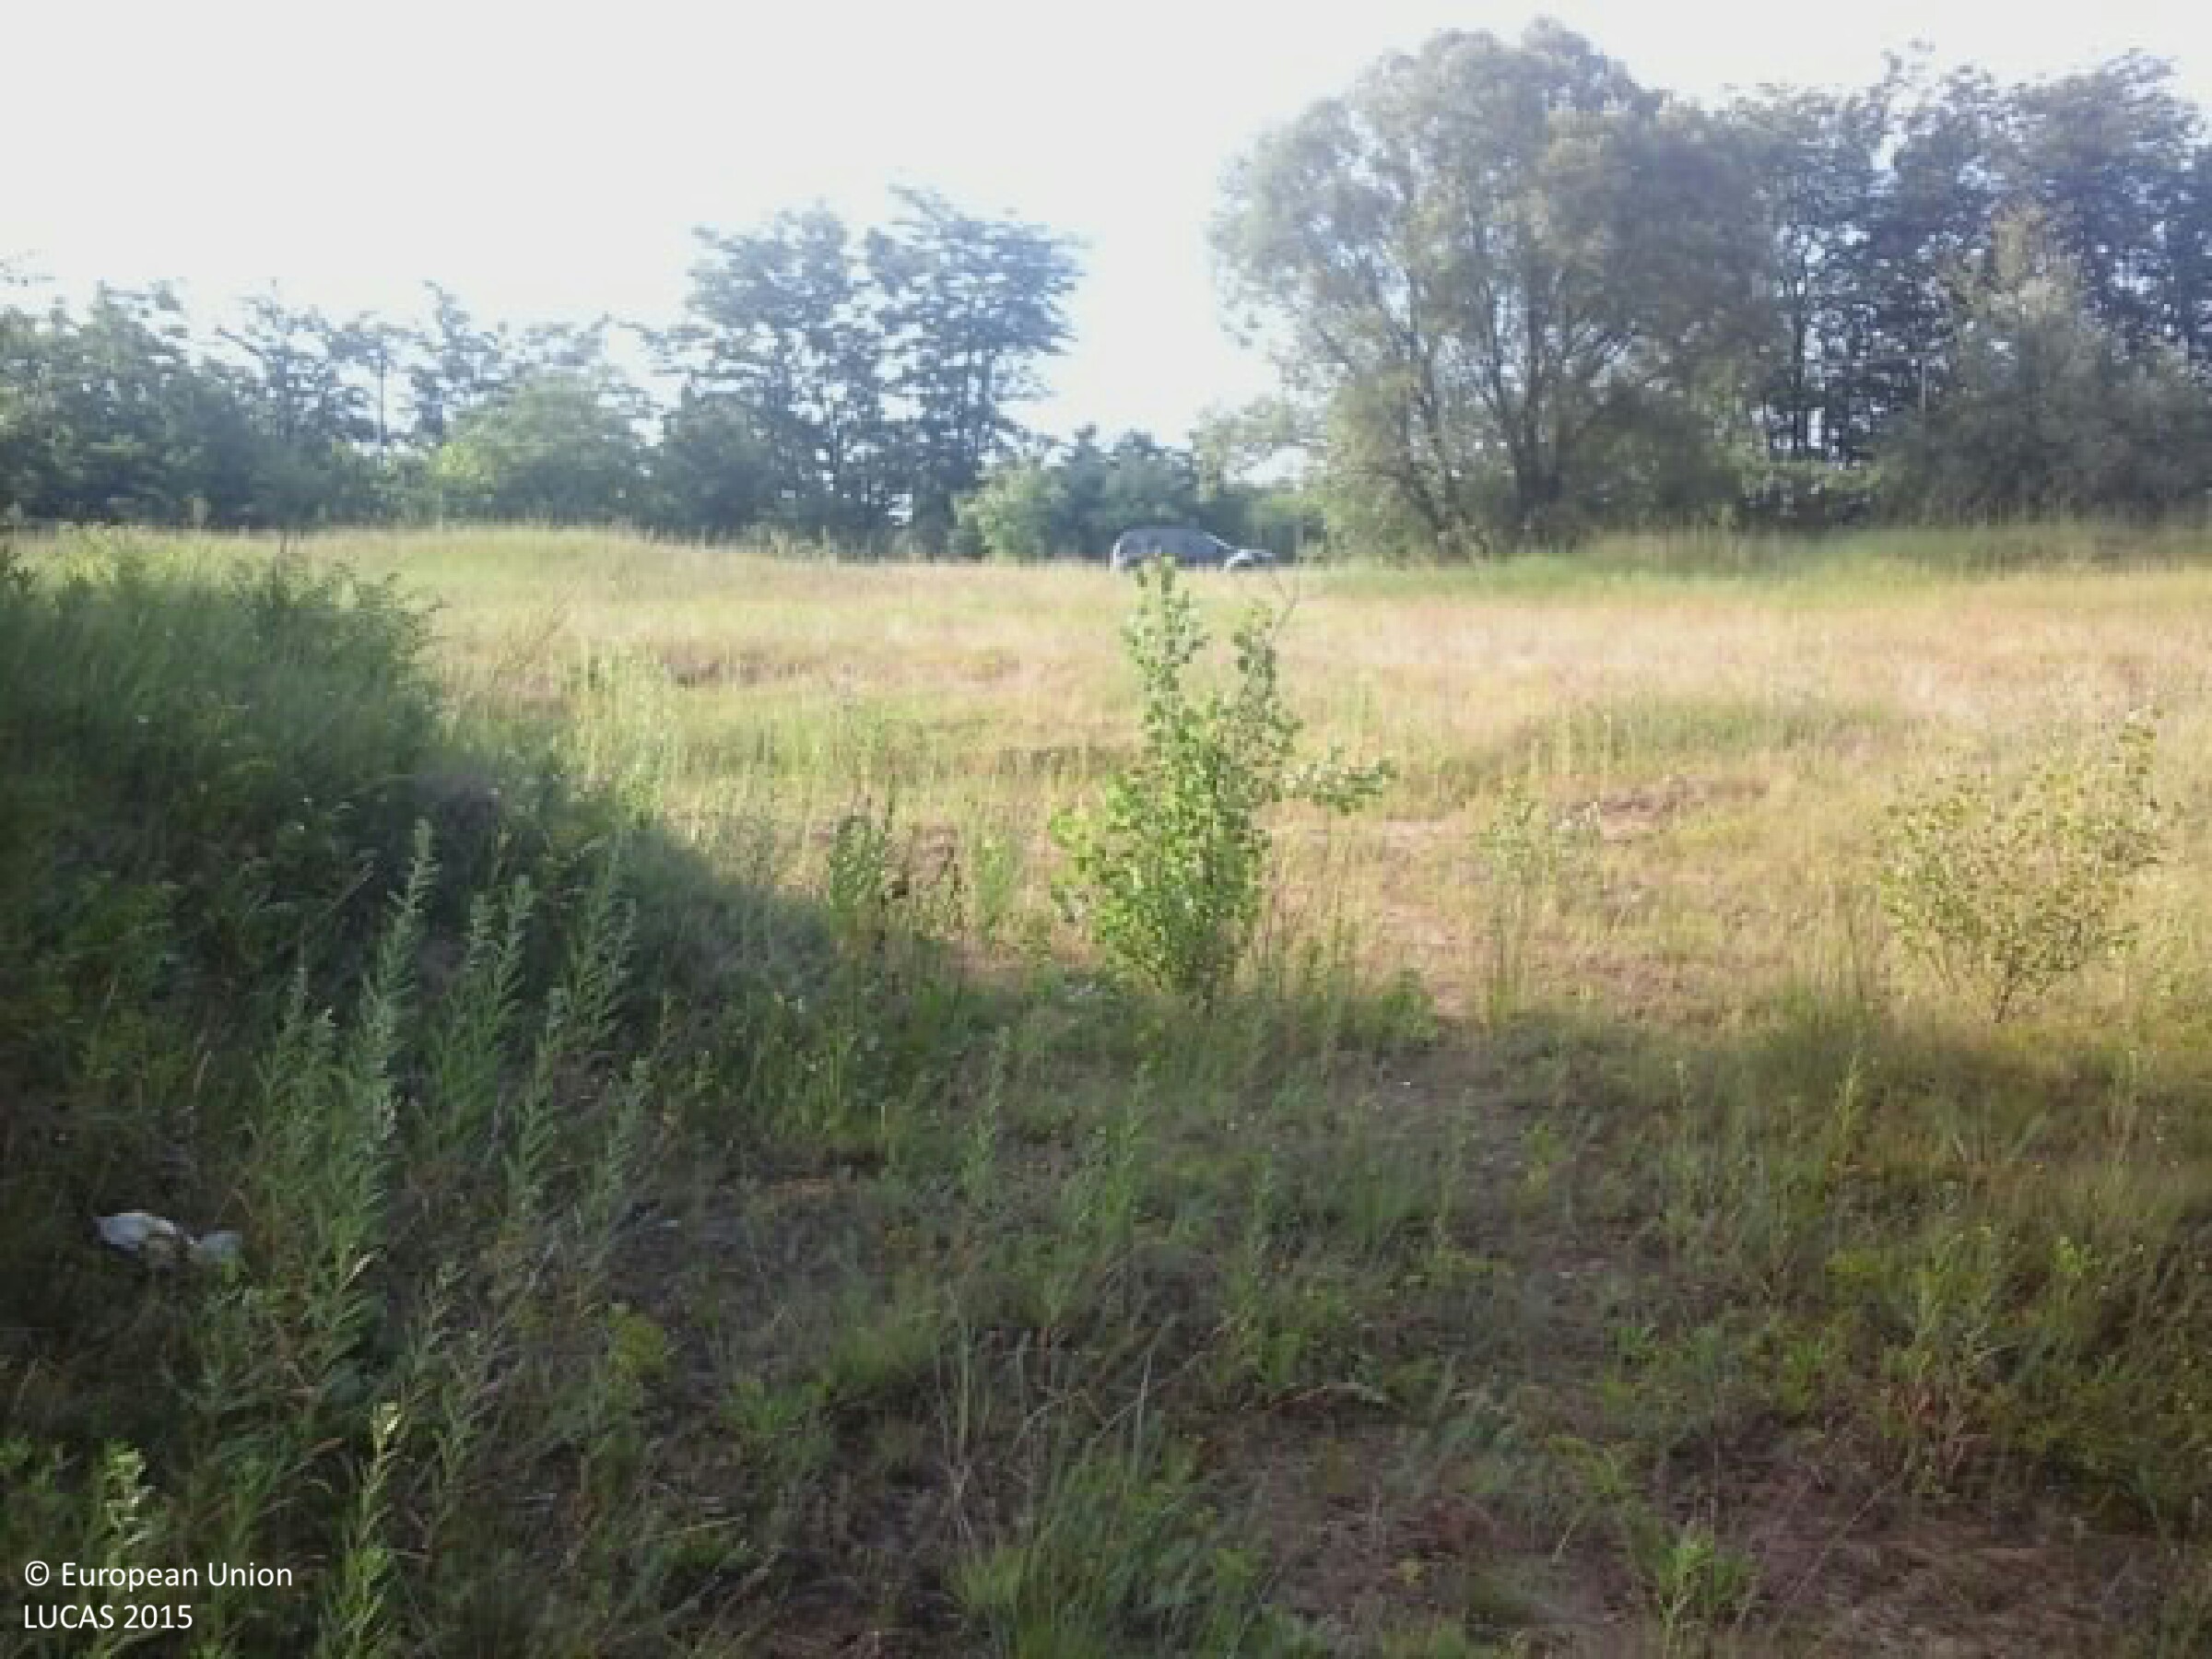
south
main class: Grassland
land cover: Grassland with sparse tree/shrub cover
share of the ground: > 75 %
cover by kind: herbaceous plants 85 %, shrubs 10 %, broadleaved forest trees 5 %
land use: Semi-natural and natural areas not in use
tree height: < 5 m
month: June
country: HU
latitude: 46.1893
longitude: 18.9913
